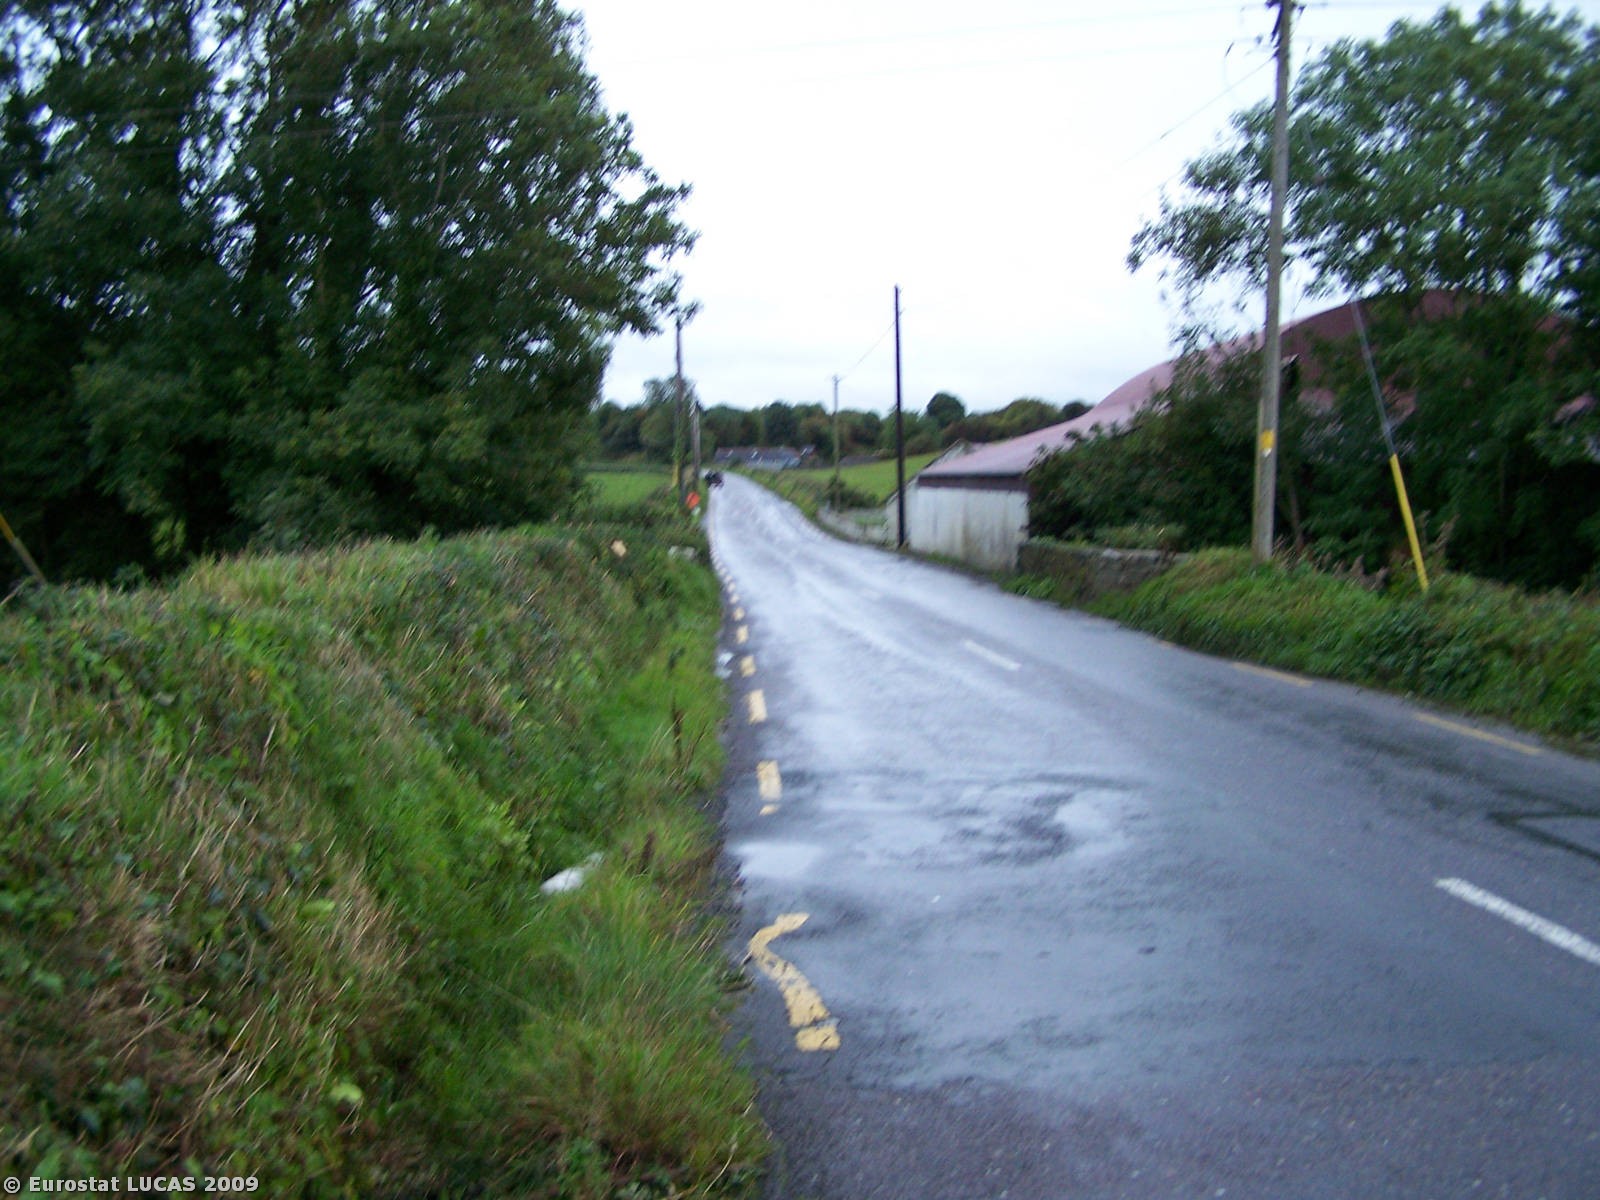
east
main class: Grassland
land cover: Grassland without tree/shrub cover
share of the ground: > 75 %
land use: Agriculture (excluding fallow land and kitchen gardens)
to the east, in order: Grassland without tree/shrub cover; Fences; Grassland without tree/shrub cover
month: September
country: IE
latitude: 52.2841
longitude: -9.6630
